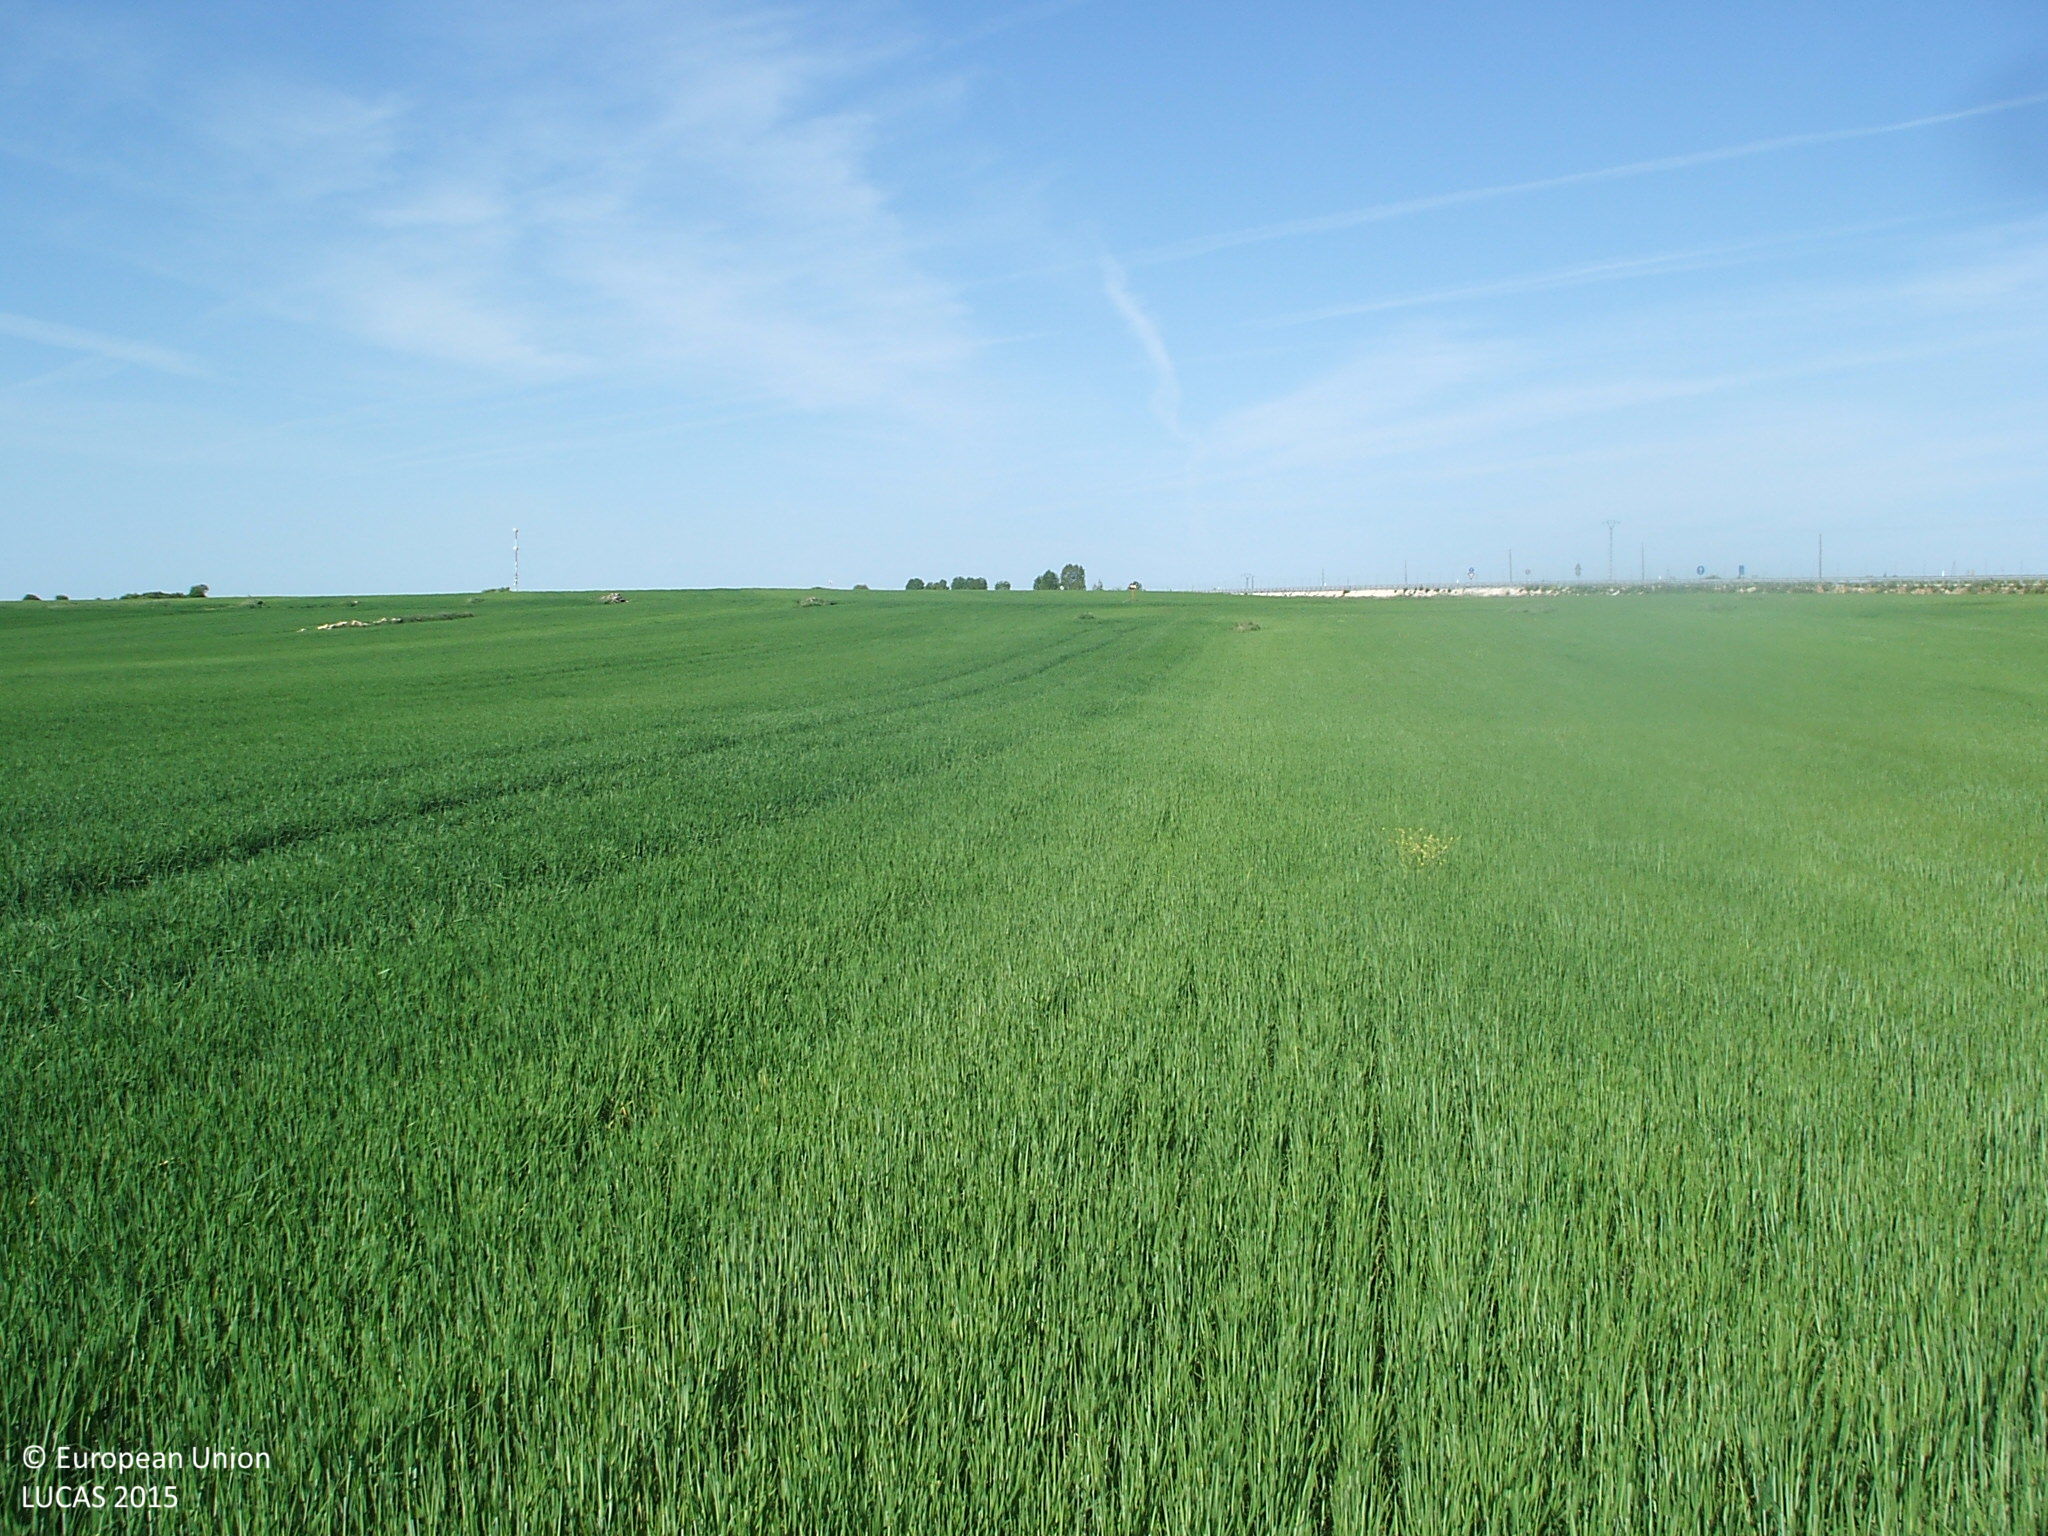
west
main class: Cropland
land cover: Barley
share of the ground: > 75 %
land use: Agriculture (excluding fallow land and kitchen gardens)
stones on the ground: > 50 %
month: May
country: ES
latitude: 40.7936
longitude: -2.9630
